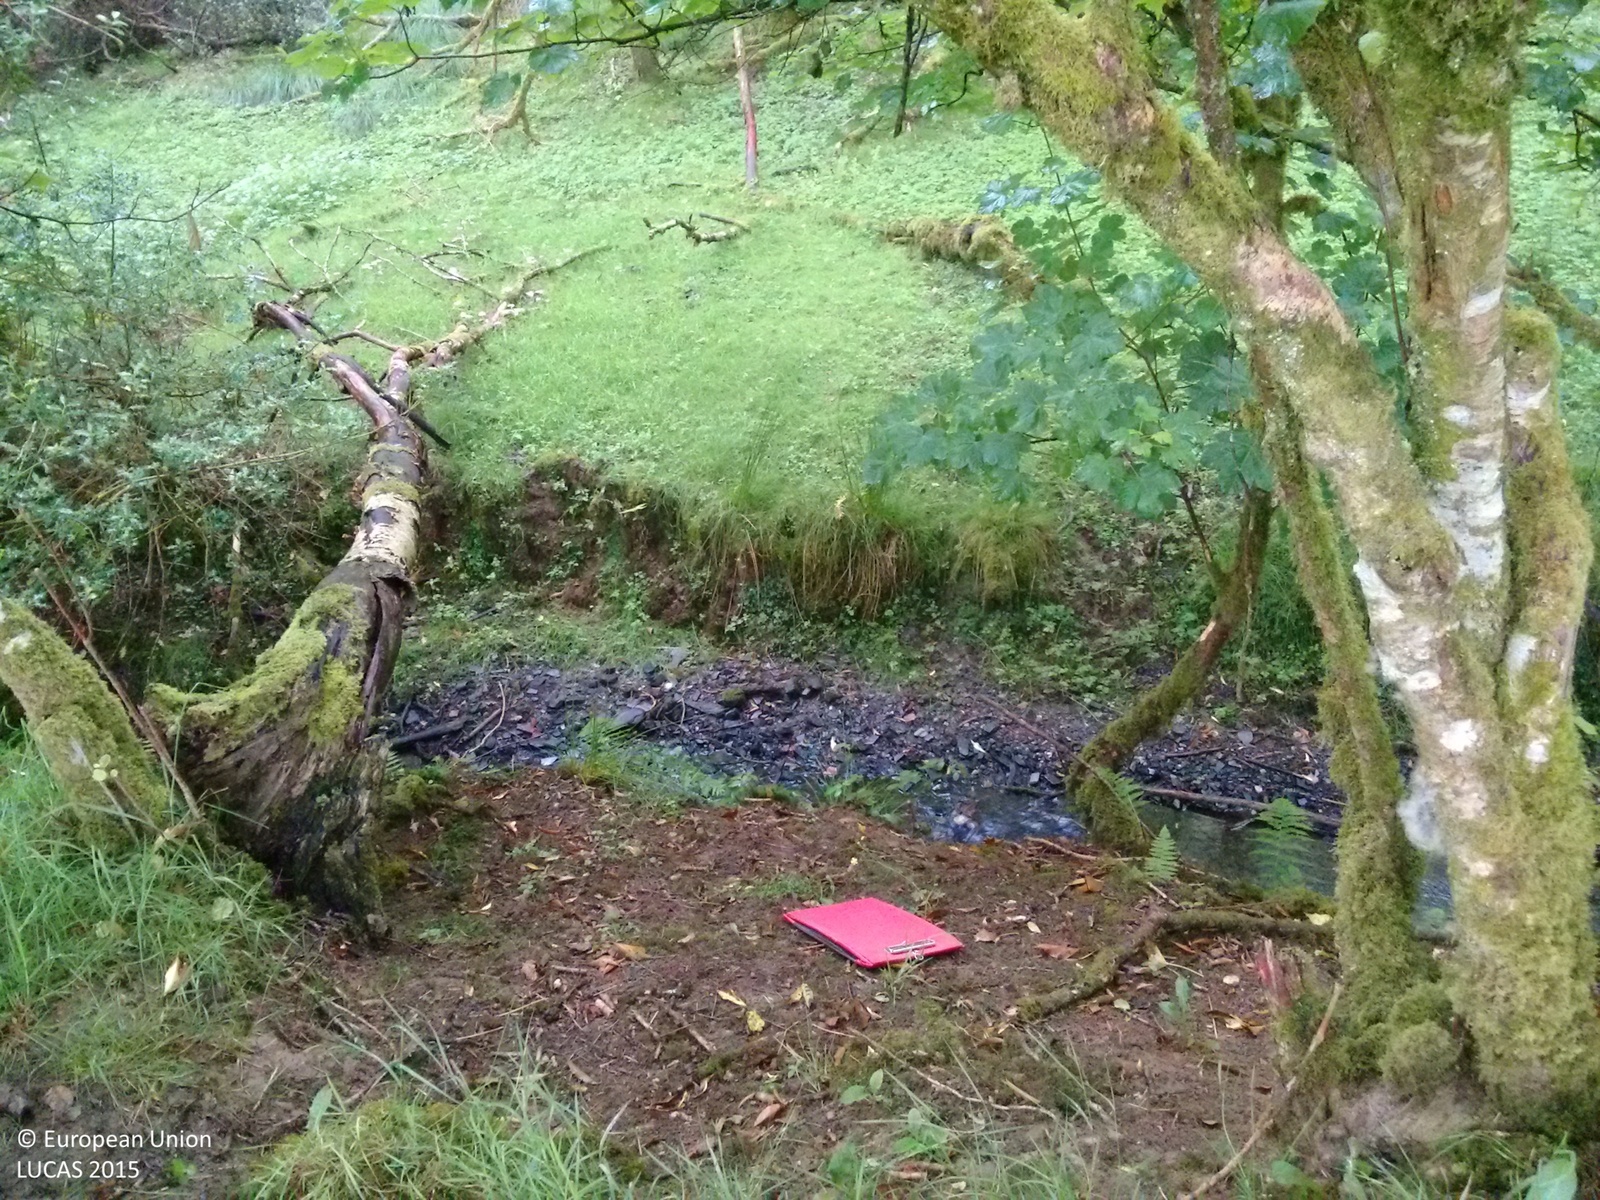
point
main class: Woodland
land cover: Broadleaved woodland
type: mesophytic deciduous forest
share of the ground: > 75 %
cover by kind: broadleaved forest trees 100 %
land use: Semi-natural and natural areas not in use
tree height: > 5 m
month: July
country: GB
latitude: 51.0115
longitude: -3.5546
